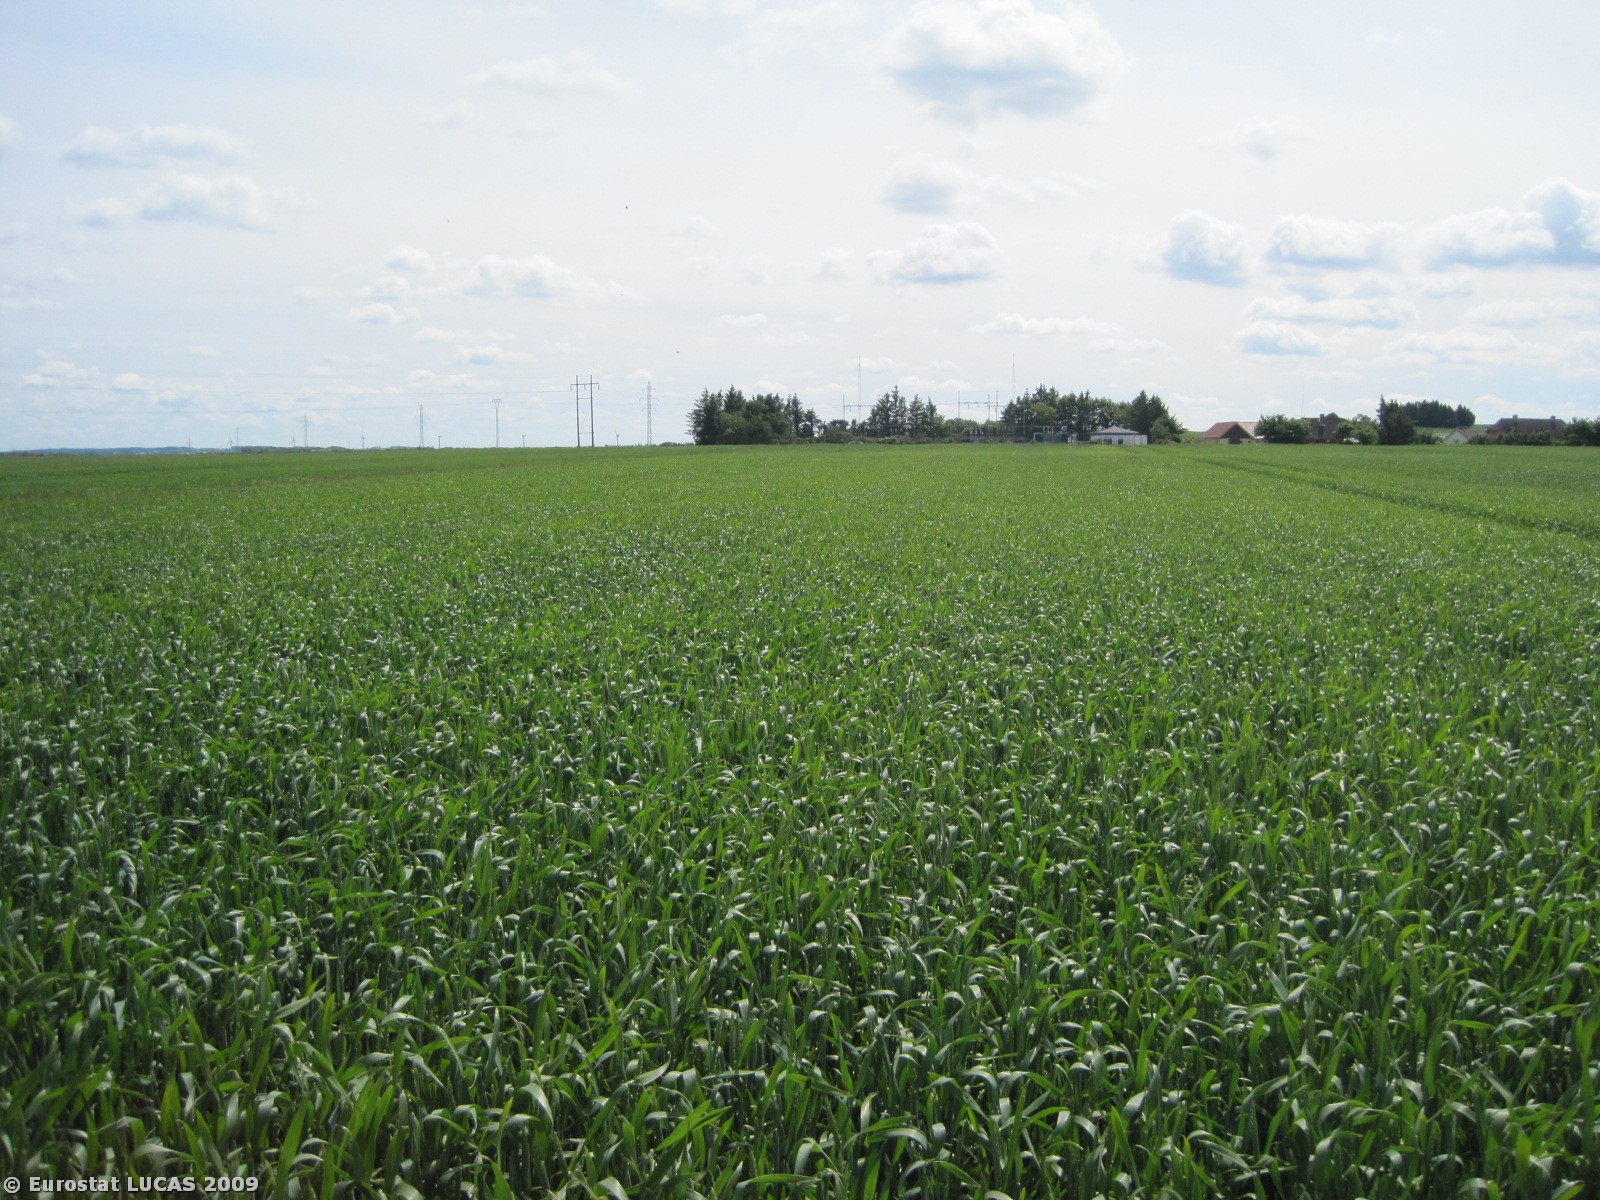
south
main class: Cropland
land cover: Common wheat
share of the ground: > 75 %
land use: Agriculture (excluding fallow land and kitchen gardens)
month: June
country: DK
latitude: 57.3741
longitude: 9.8174
